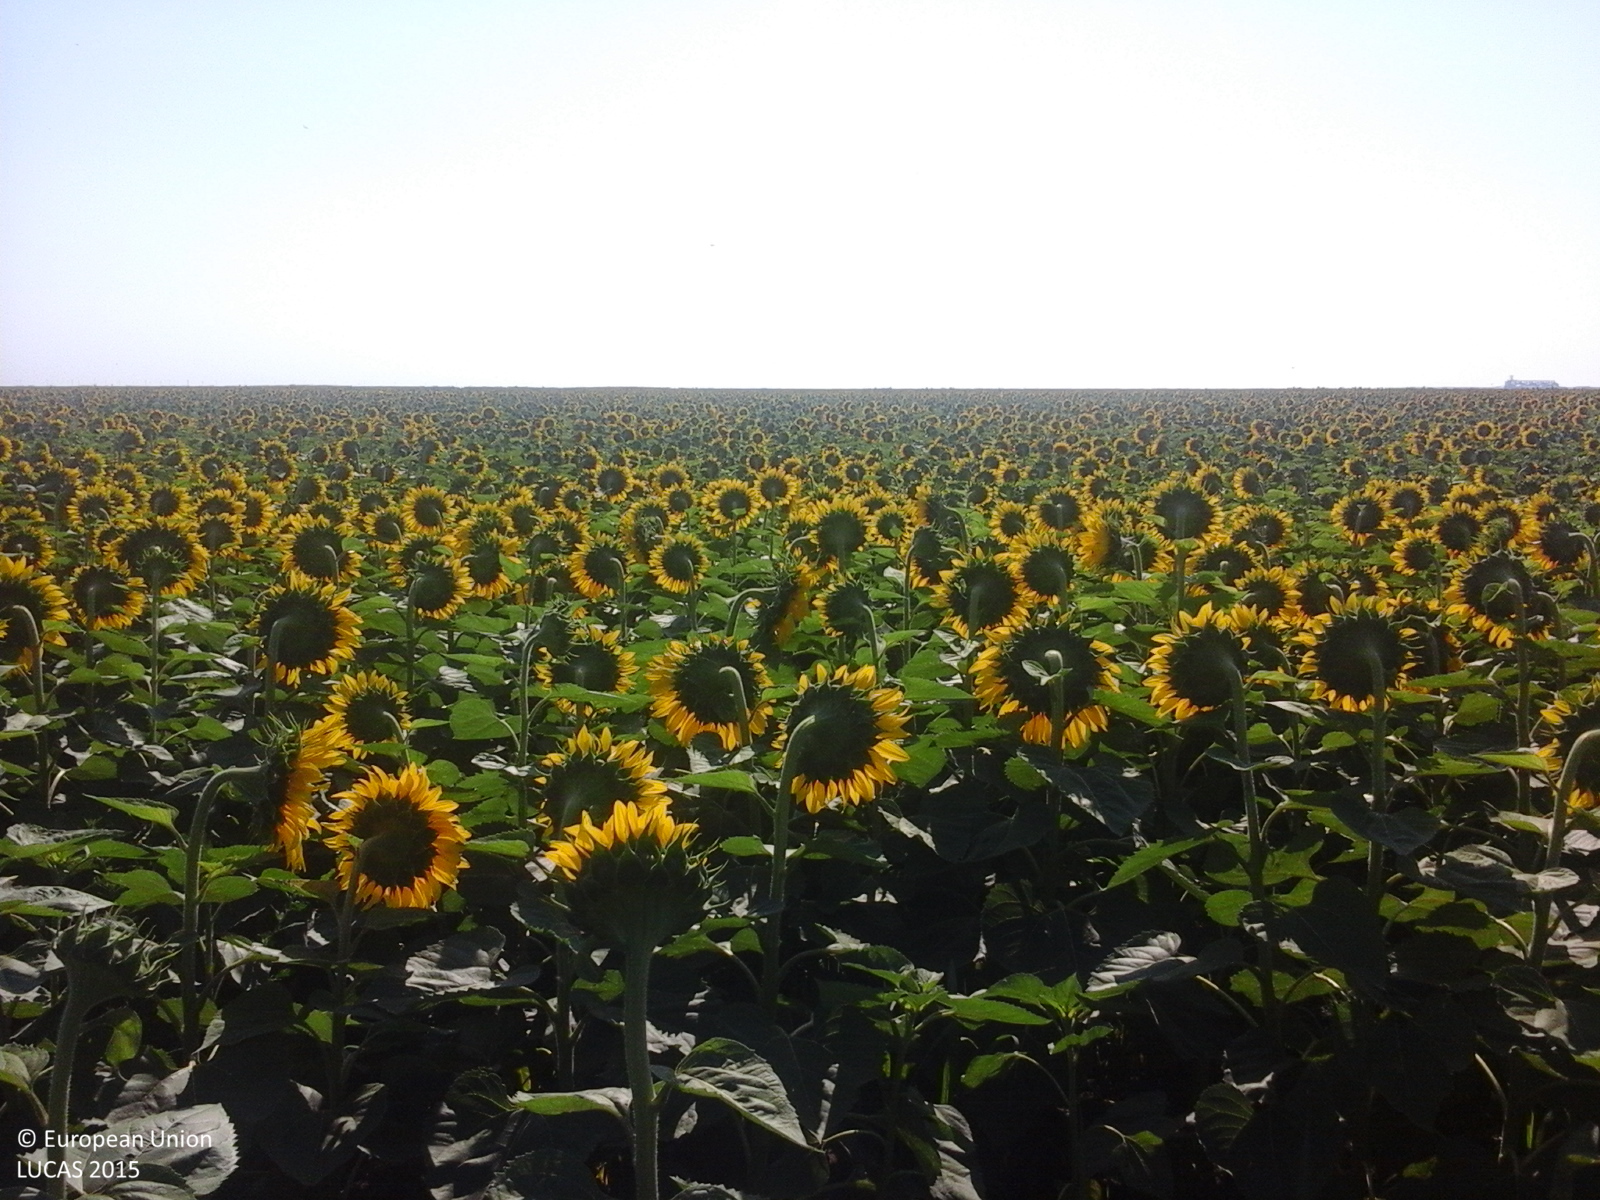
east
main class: Cropland
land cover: Sunflower
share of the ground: > 75 %
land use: Agriculture (excluding fallow land and kitchen gardens)
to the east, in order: Sunflower
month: July
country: RO
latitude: 44.1322
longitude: 25.3712
